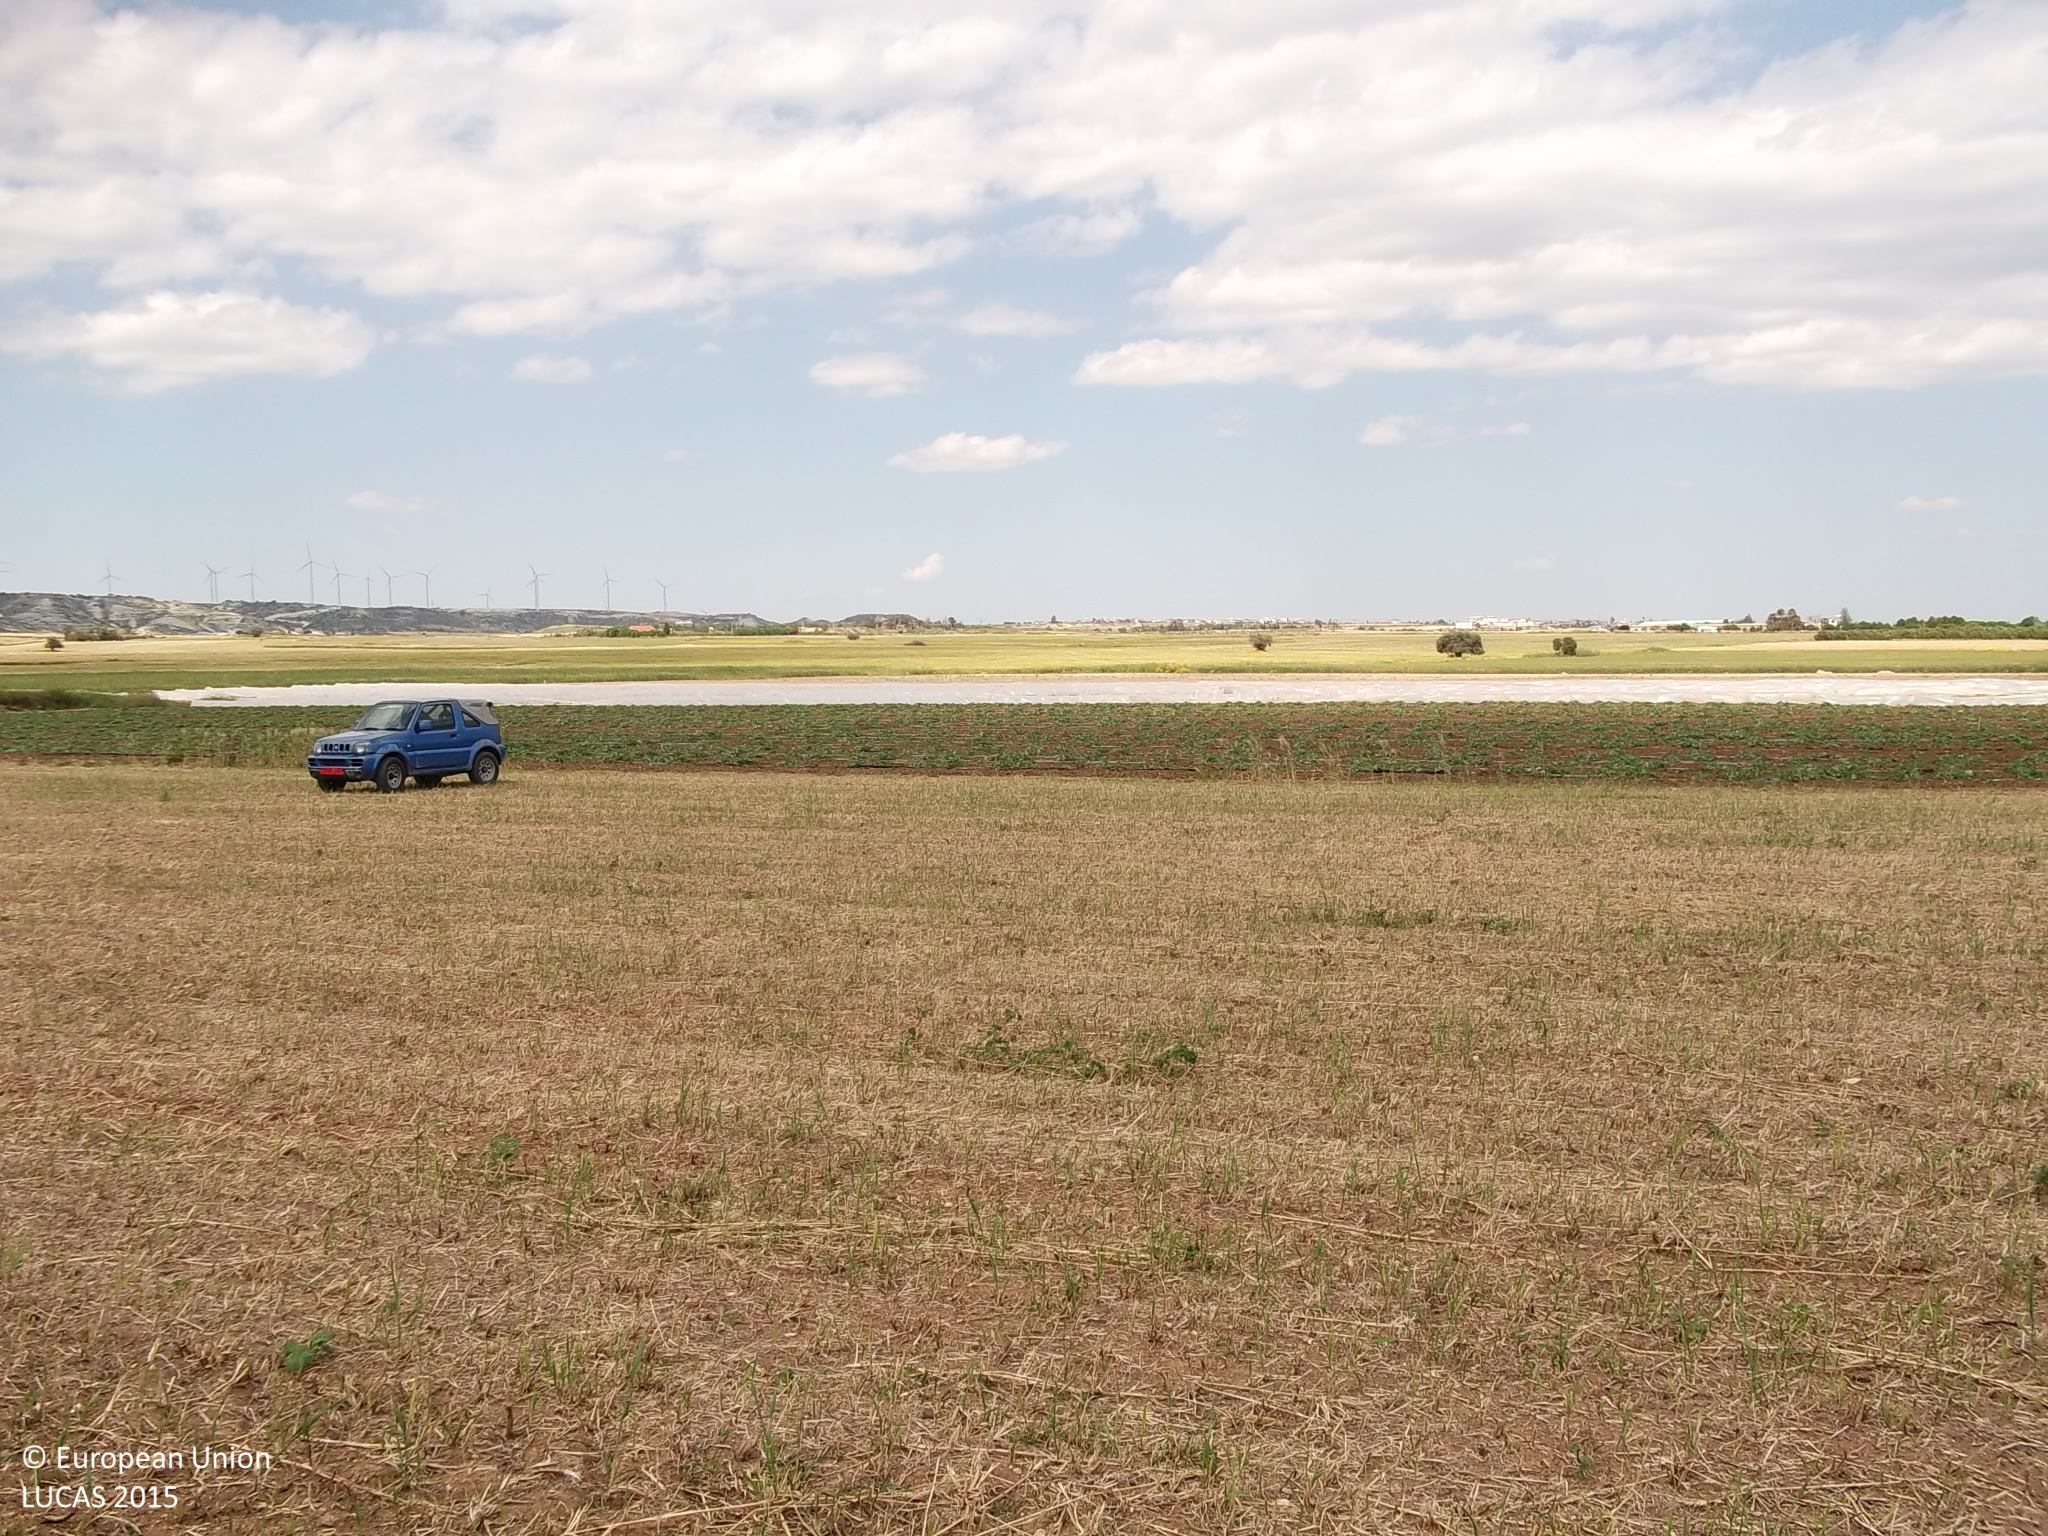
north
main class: Cropland
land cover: Common wheat
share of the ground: < 10 %
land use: Agriculture (excluding fallow land and kitchen gardens)
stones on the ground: < 10 %
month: April
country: CY
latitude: 34.8251
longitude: 33.5324
